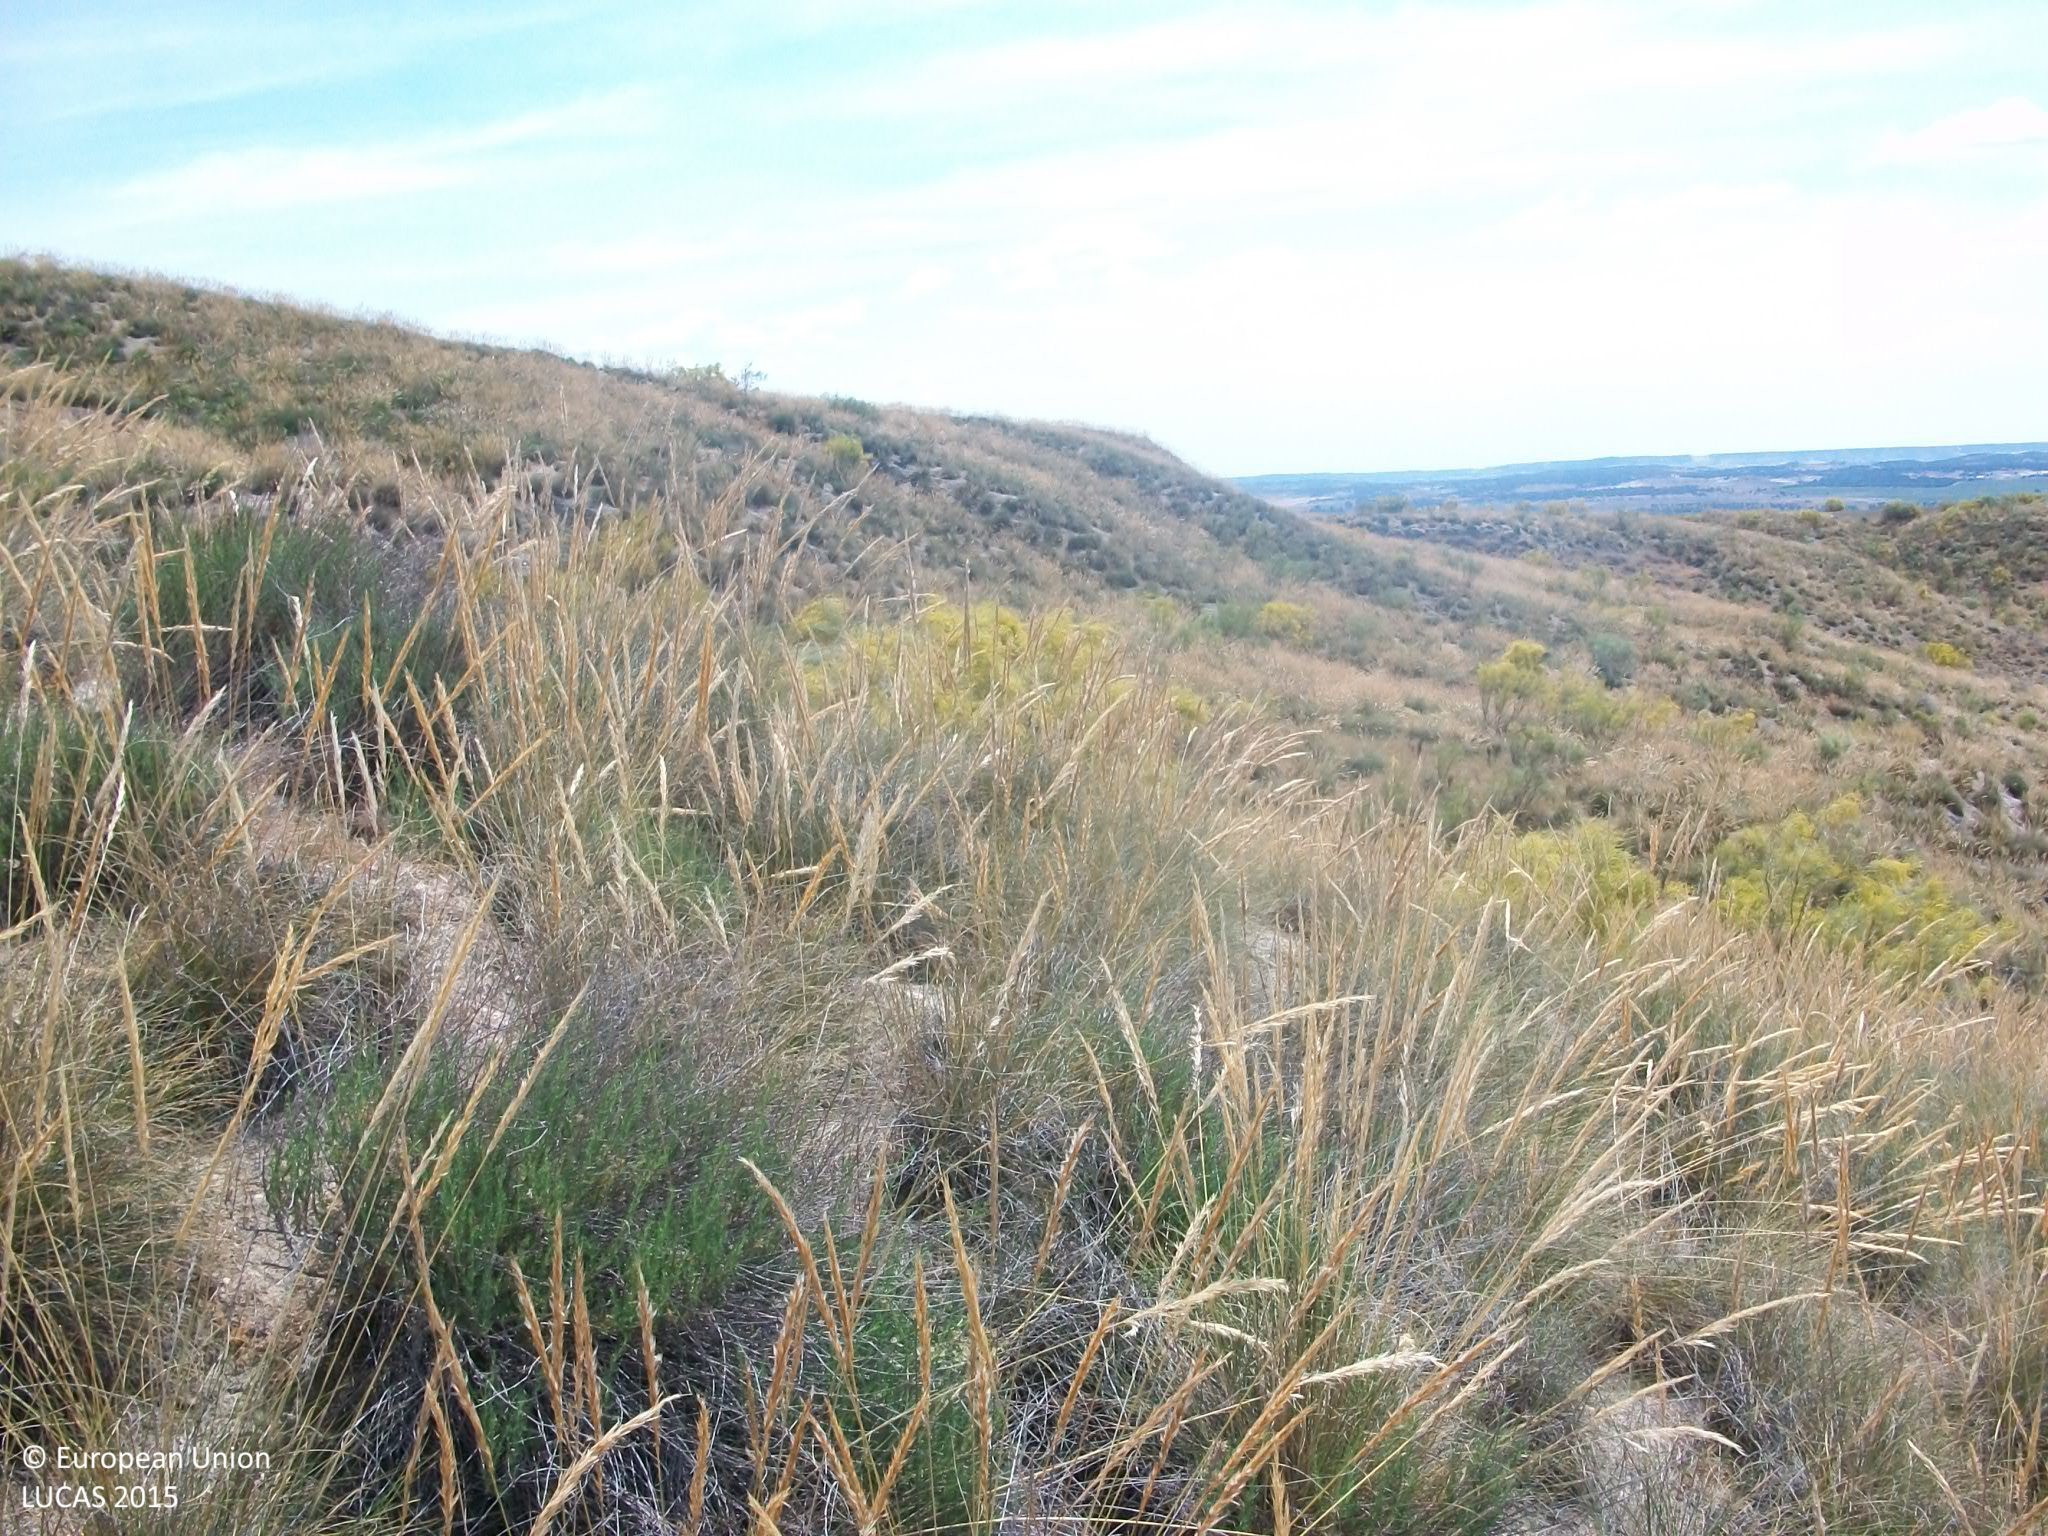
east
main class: Shrubland
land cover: Shrubland without tree cover
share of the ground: > 75 %
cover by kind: shrubs 90 %, consolidated bare surface 10 %
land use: Semi-natural and natural areas not in use
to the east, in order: Shrubland without tree cover
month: May
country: ES
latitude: 40.0329
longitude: -3.7085
